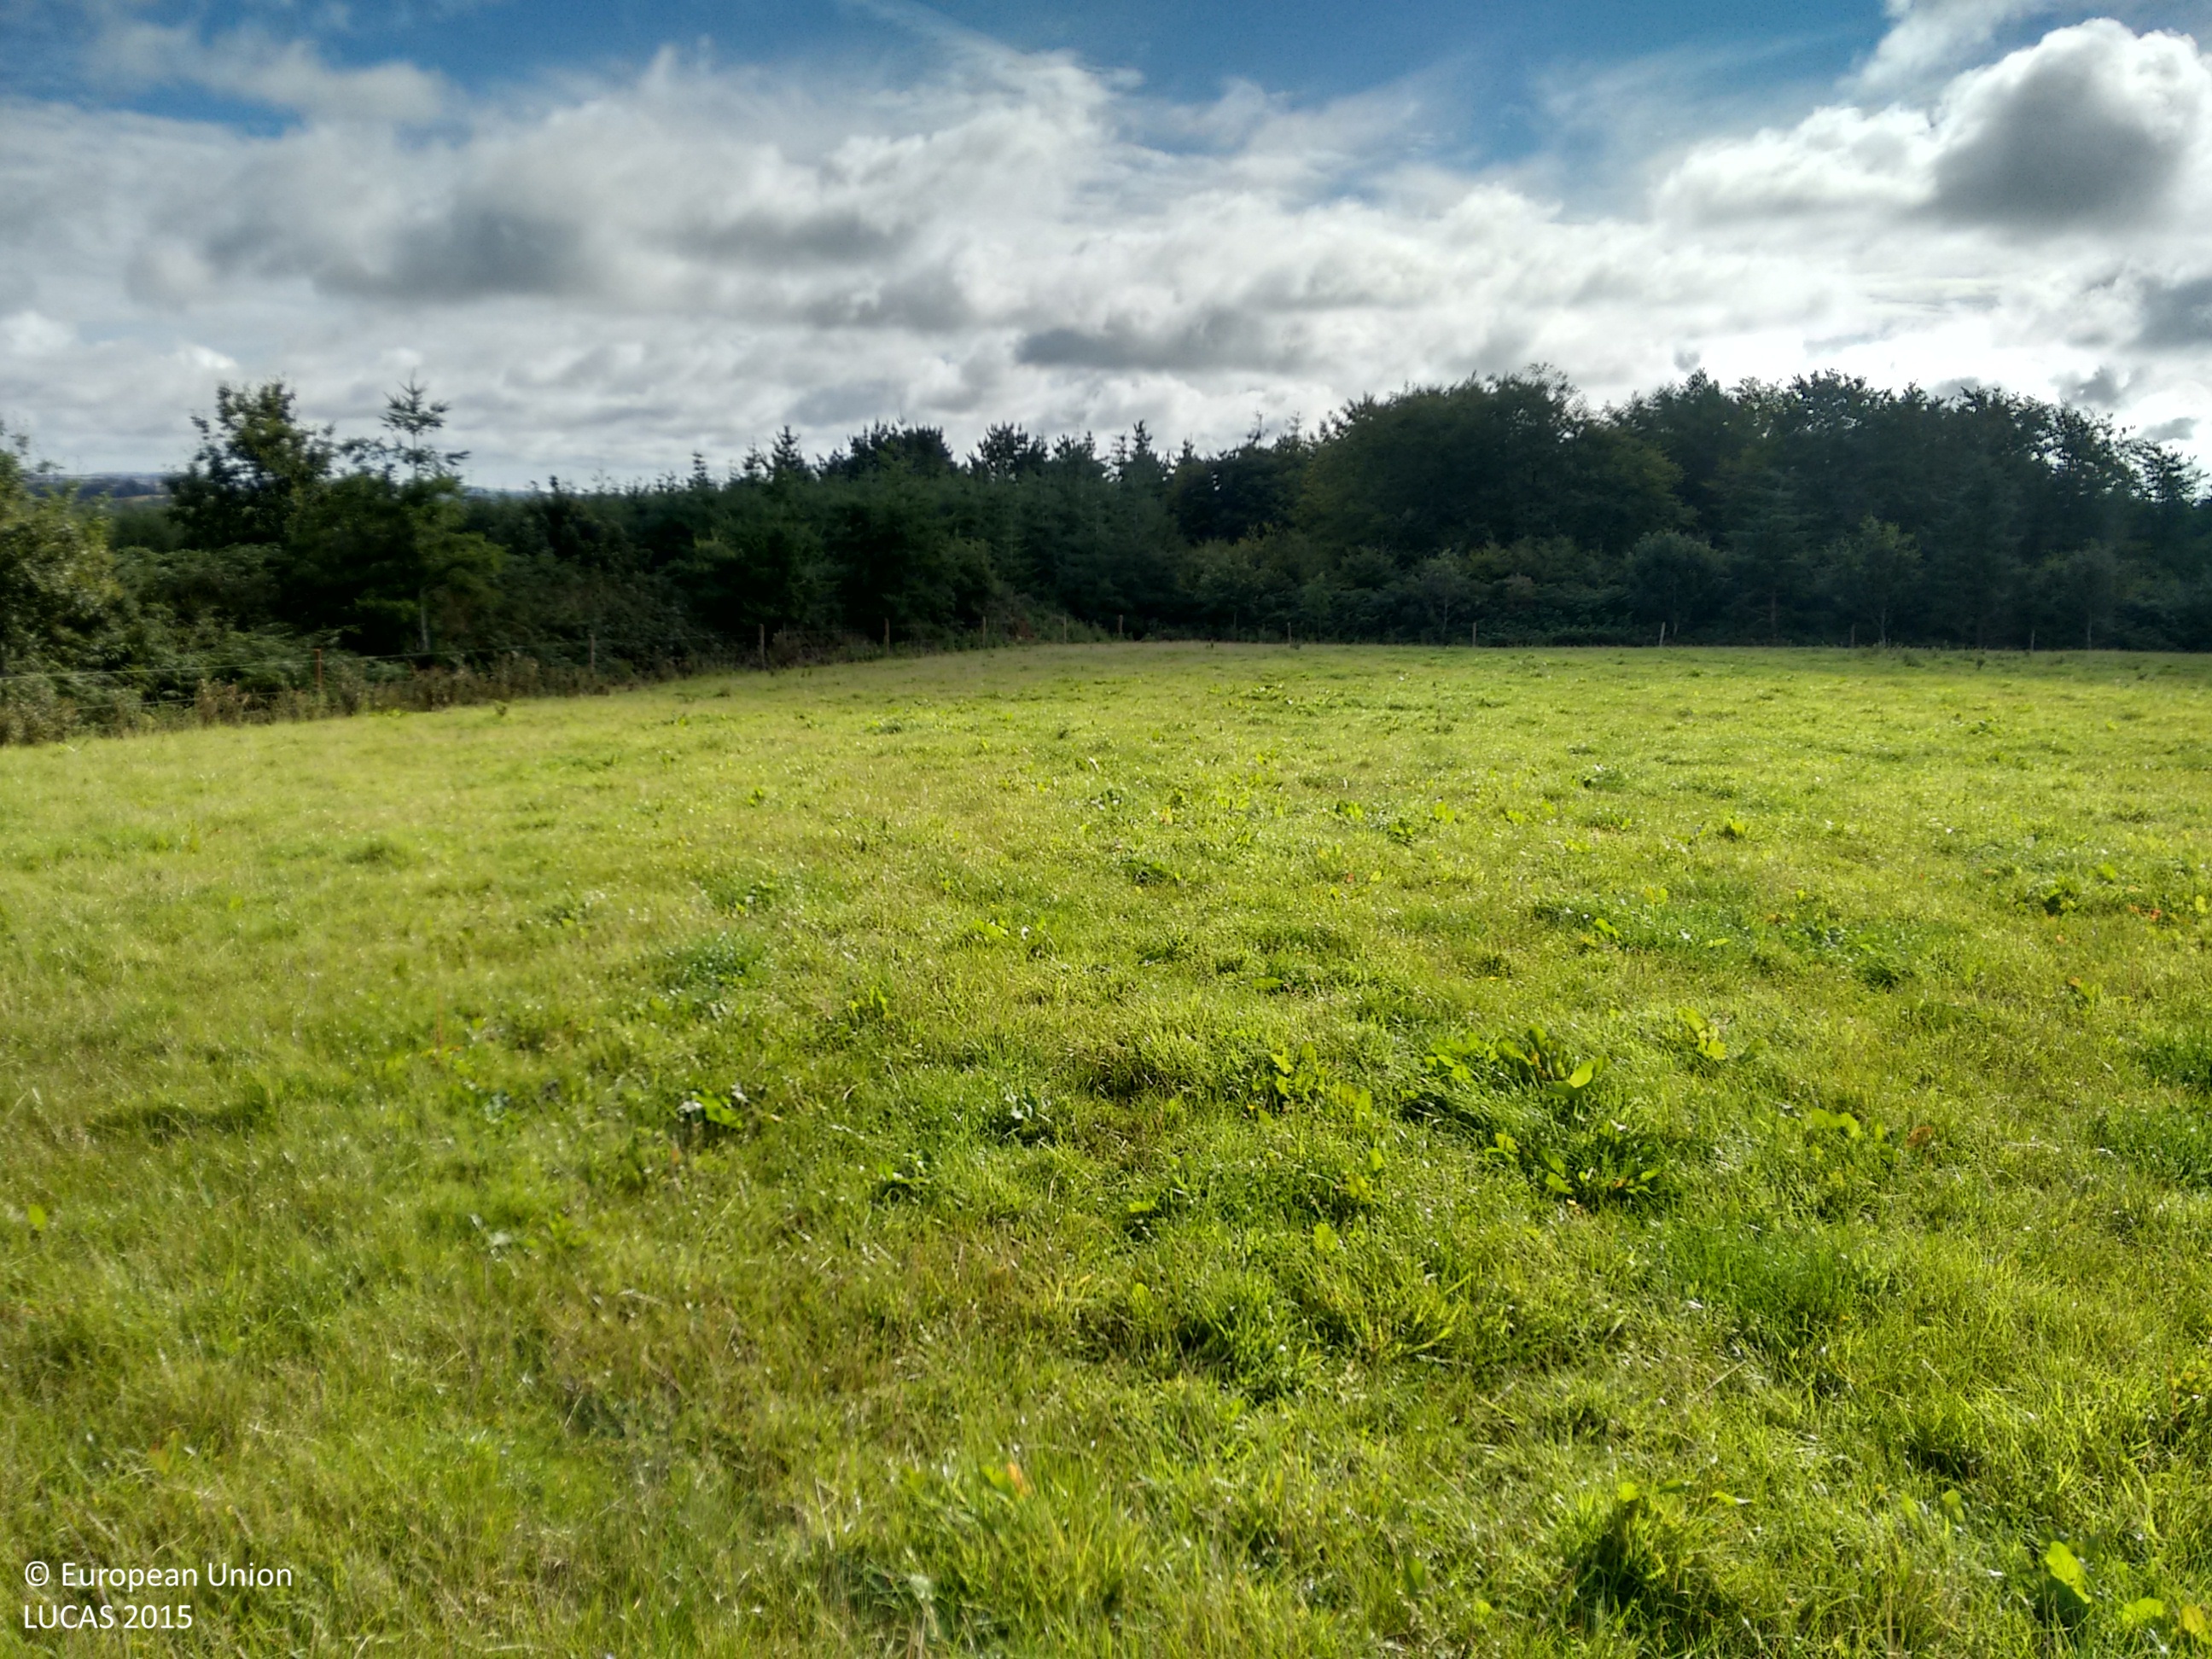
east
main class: Grassland
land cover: Grassland without tree/shrub cover
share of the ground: > 75 %
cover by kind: herbaceous plants 100 %
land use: Agriculture (excluding fallow land and kitchen gardens)
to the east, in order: Grassland without tree/shrub cover; Fences; Spruce dominated coniferous woodland; Broadleaved woodland; Grassland without tree/shrub cover; Shrubland with sparse tree cover; Spruce dominated coniferous woodland
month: August
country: IE
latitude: 52.4216
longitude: -6.6454
